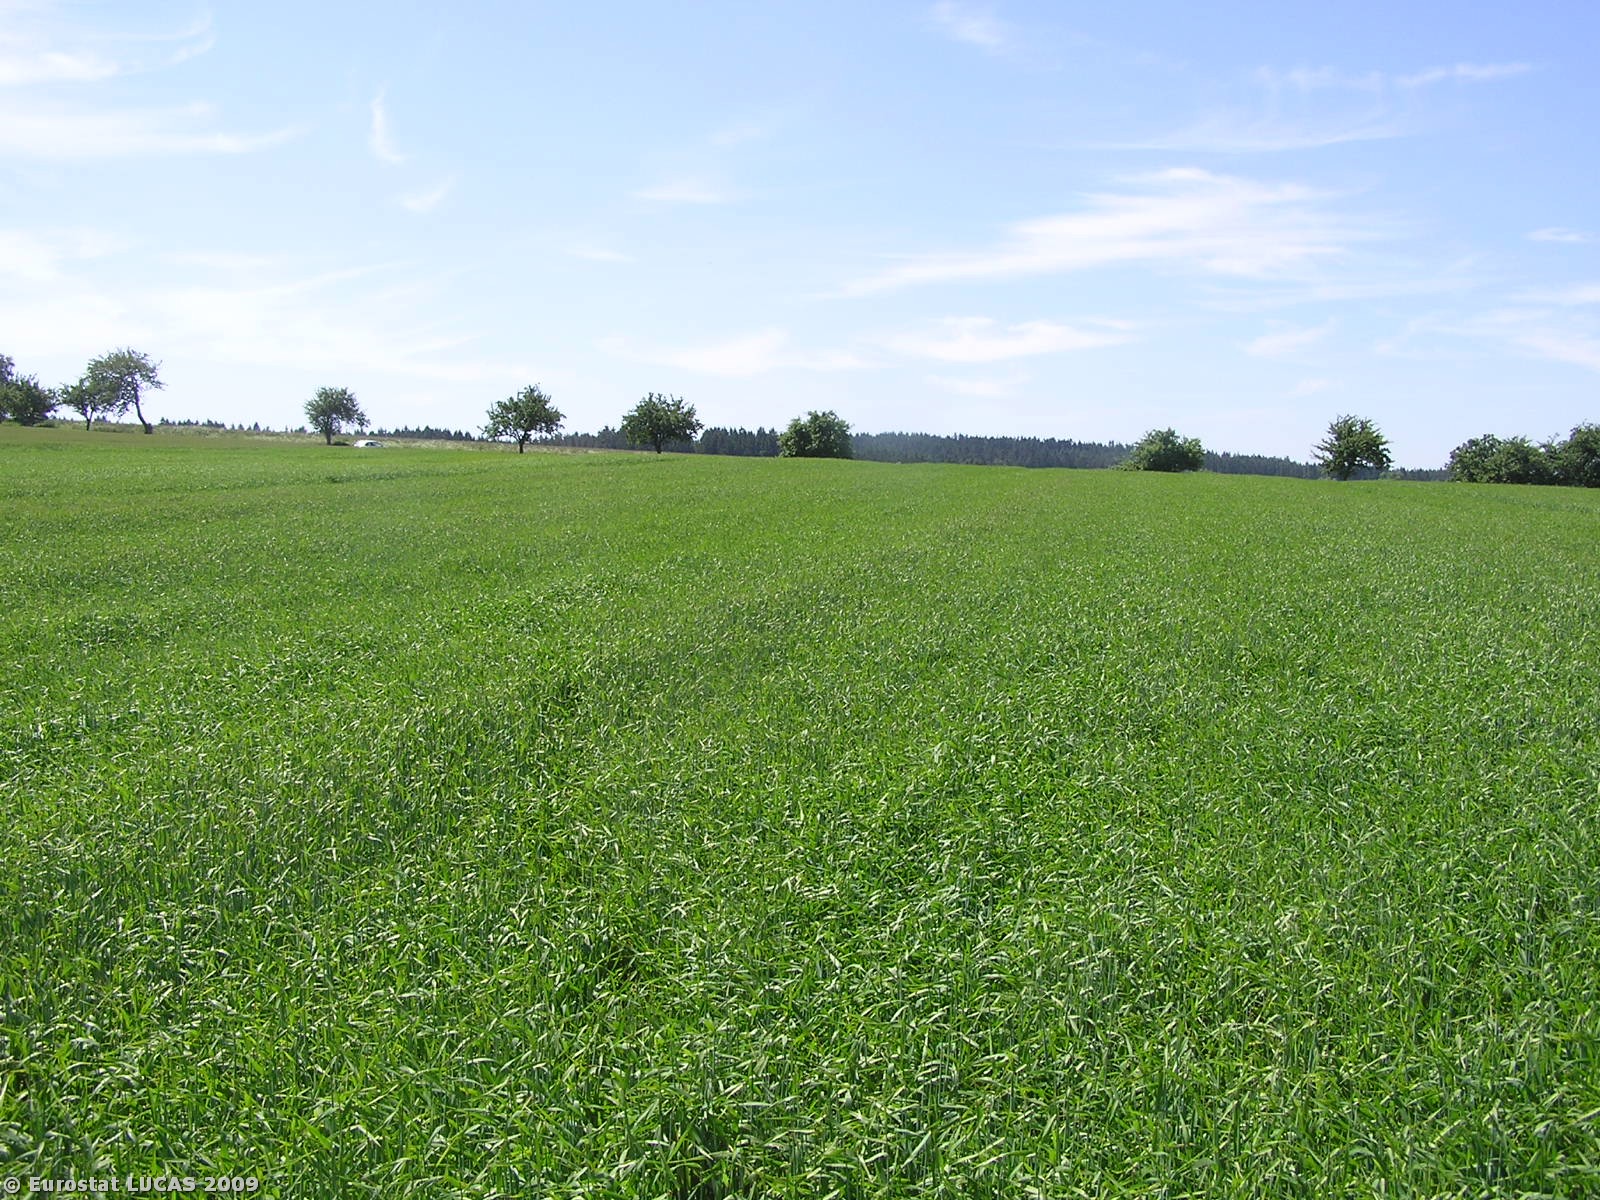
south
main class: Cropland
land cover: Barley
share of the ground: > 75 %
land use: Agriculture (excluding fallow land and kitchen gardens)
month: June
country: CZ
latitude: 49.3216
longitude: 14.9137
